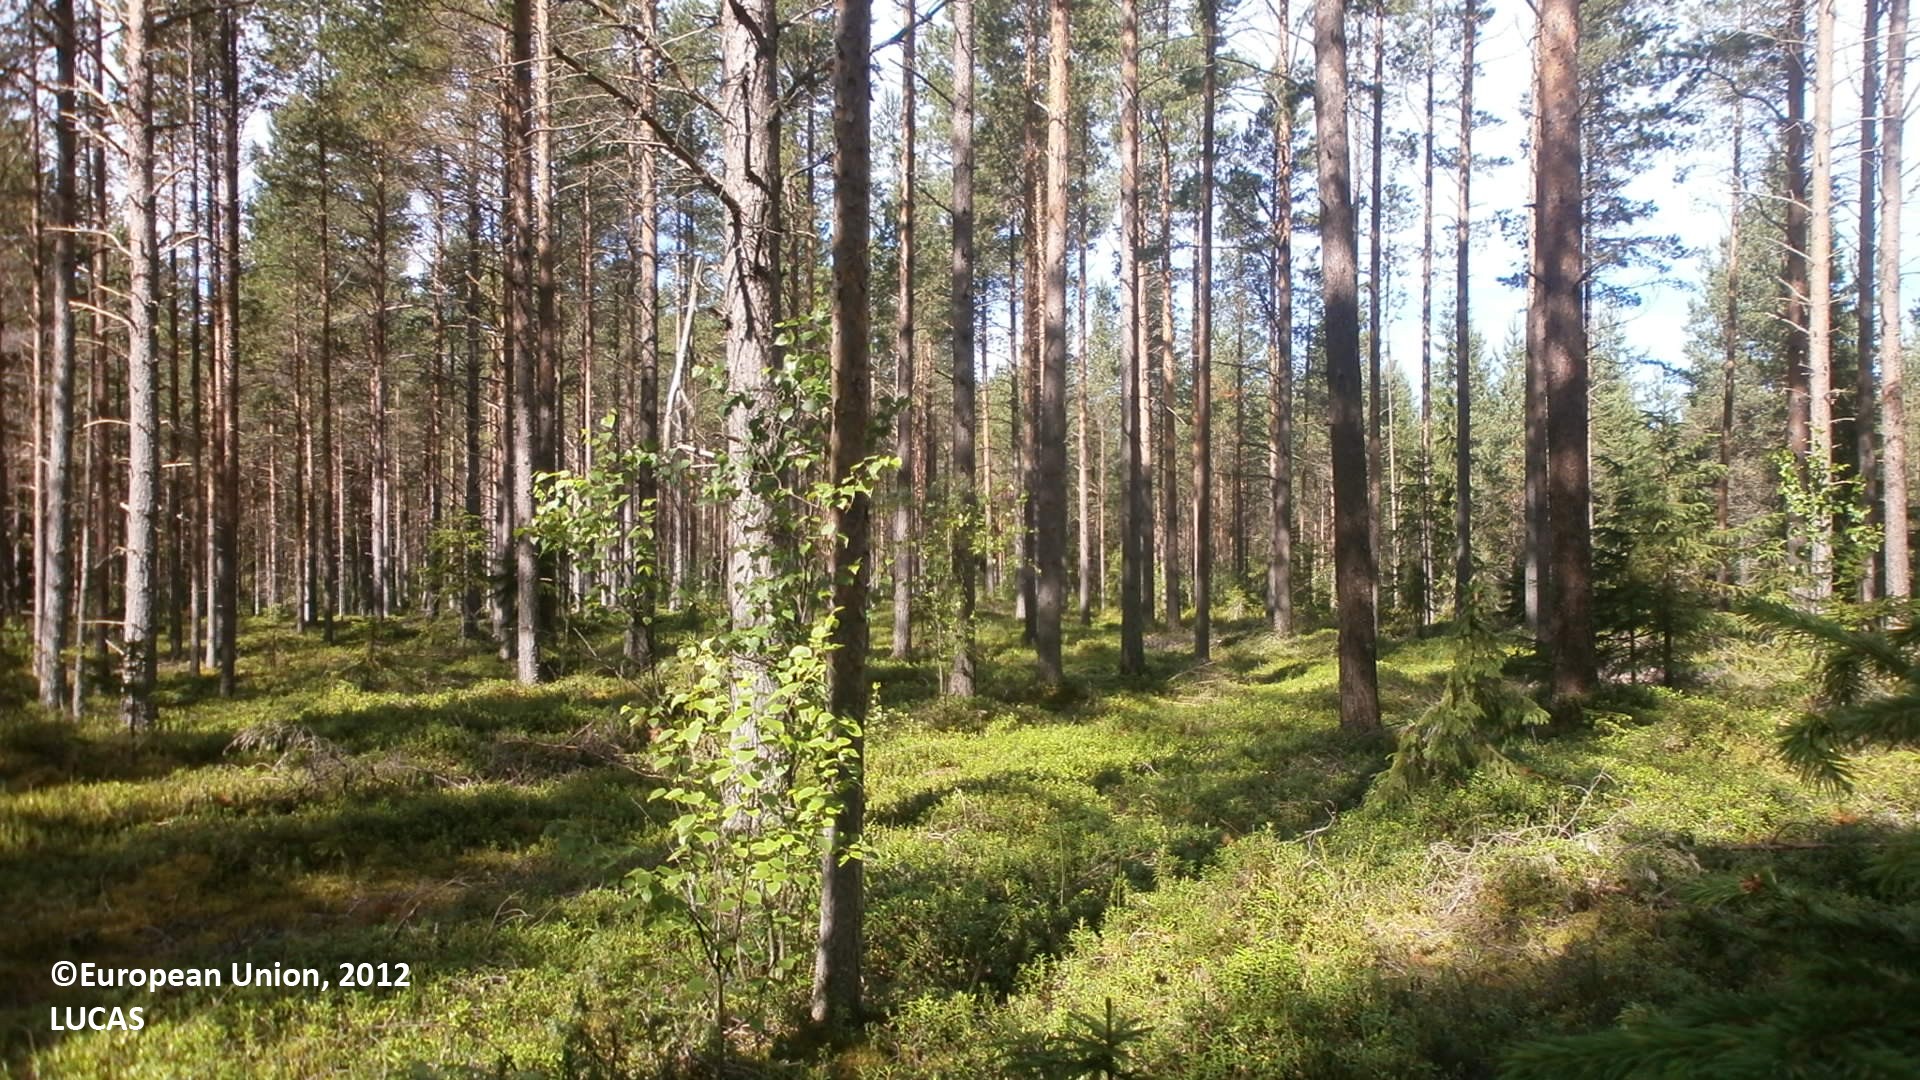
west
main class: Woodland
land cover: Pine dominated coniferous woodland
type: boreal forest
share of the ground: 50 - 75 %
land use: Forestry
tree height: > 5 m
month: July
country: FI
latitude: 64.3867
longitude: 24.1413
